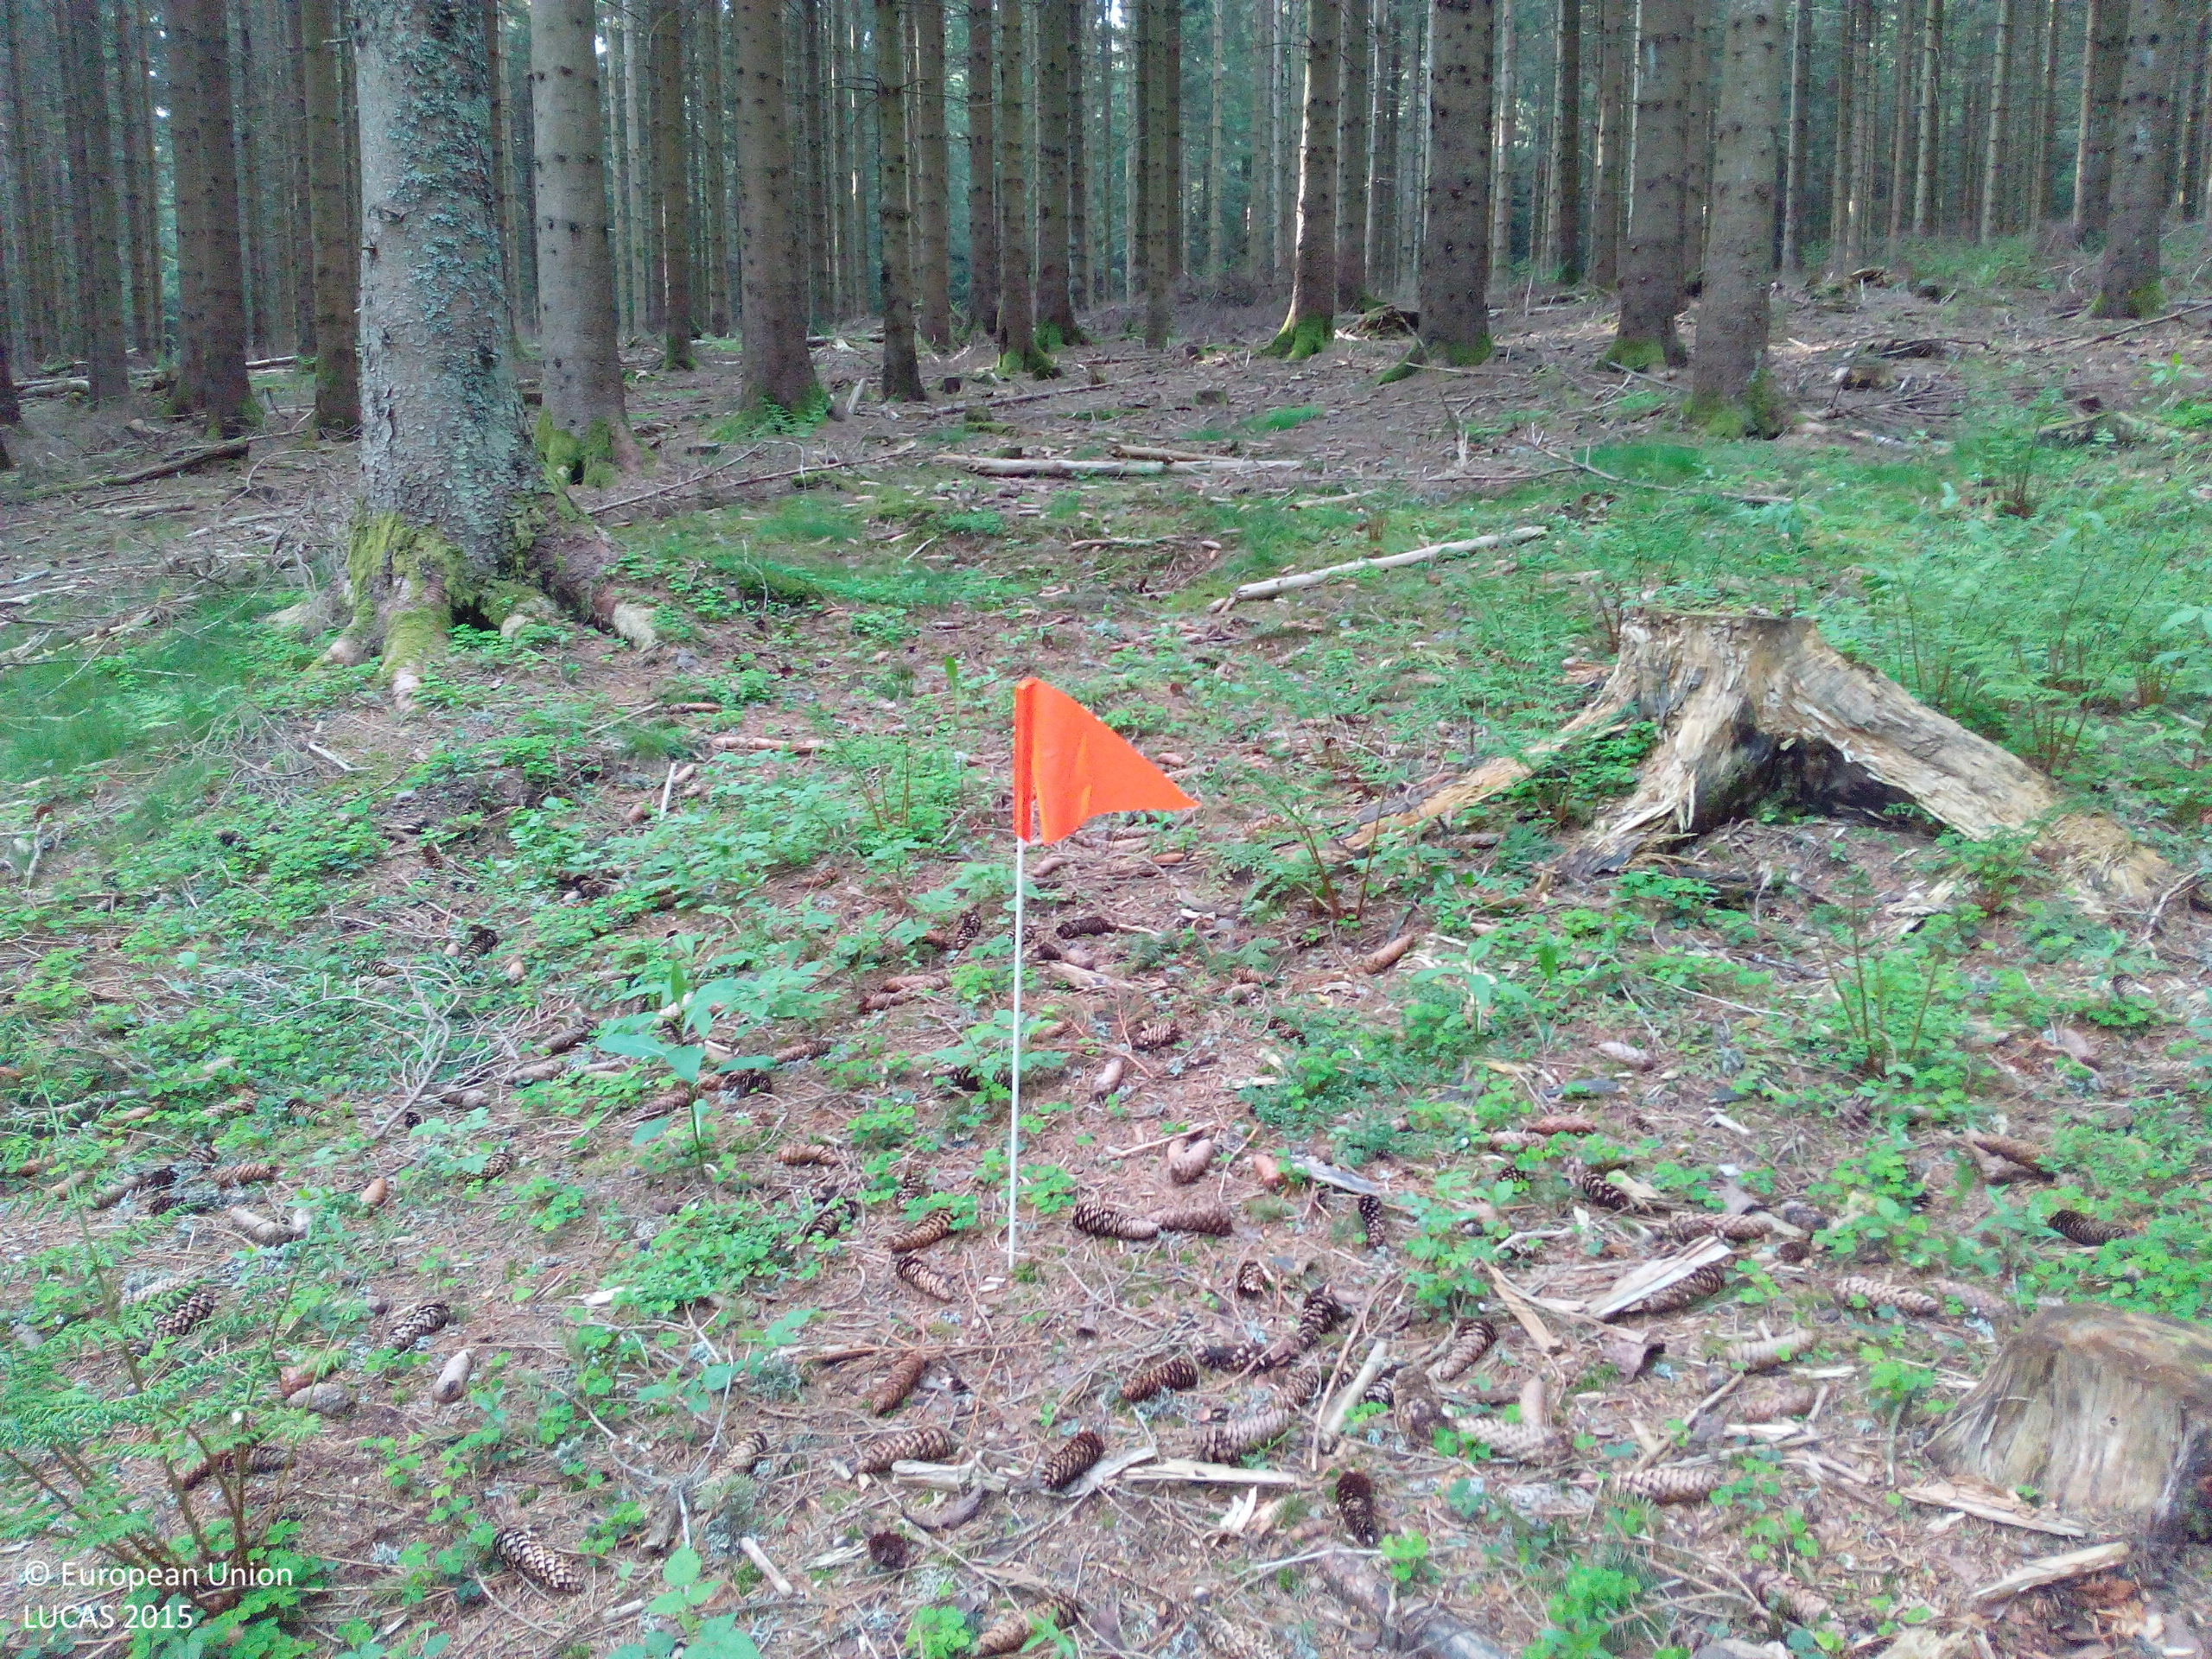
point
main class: Woodland
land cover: Spruce dominated coniferous woodland
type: hemiboreal forest and nemoral coniferous forest and mixed broadleaved-coniferous forest
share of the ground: > 75 %
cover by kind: coniferous forest trees 95 %, herbaceous plants 5 %
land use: Forestry
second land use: Amenities, museums, leisure
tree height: > 5 m
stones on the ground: < 10 %
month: May
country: DE
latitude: 48.1007
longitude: 8.1881
